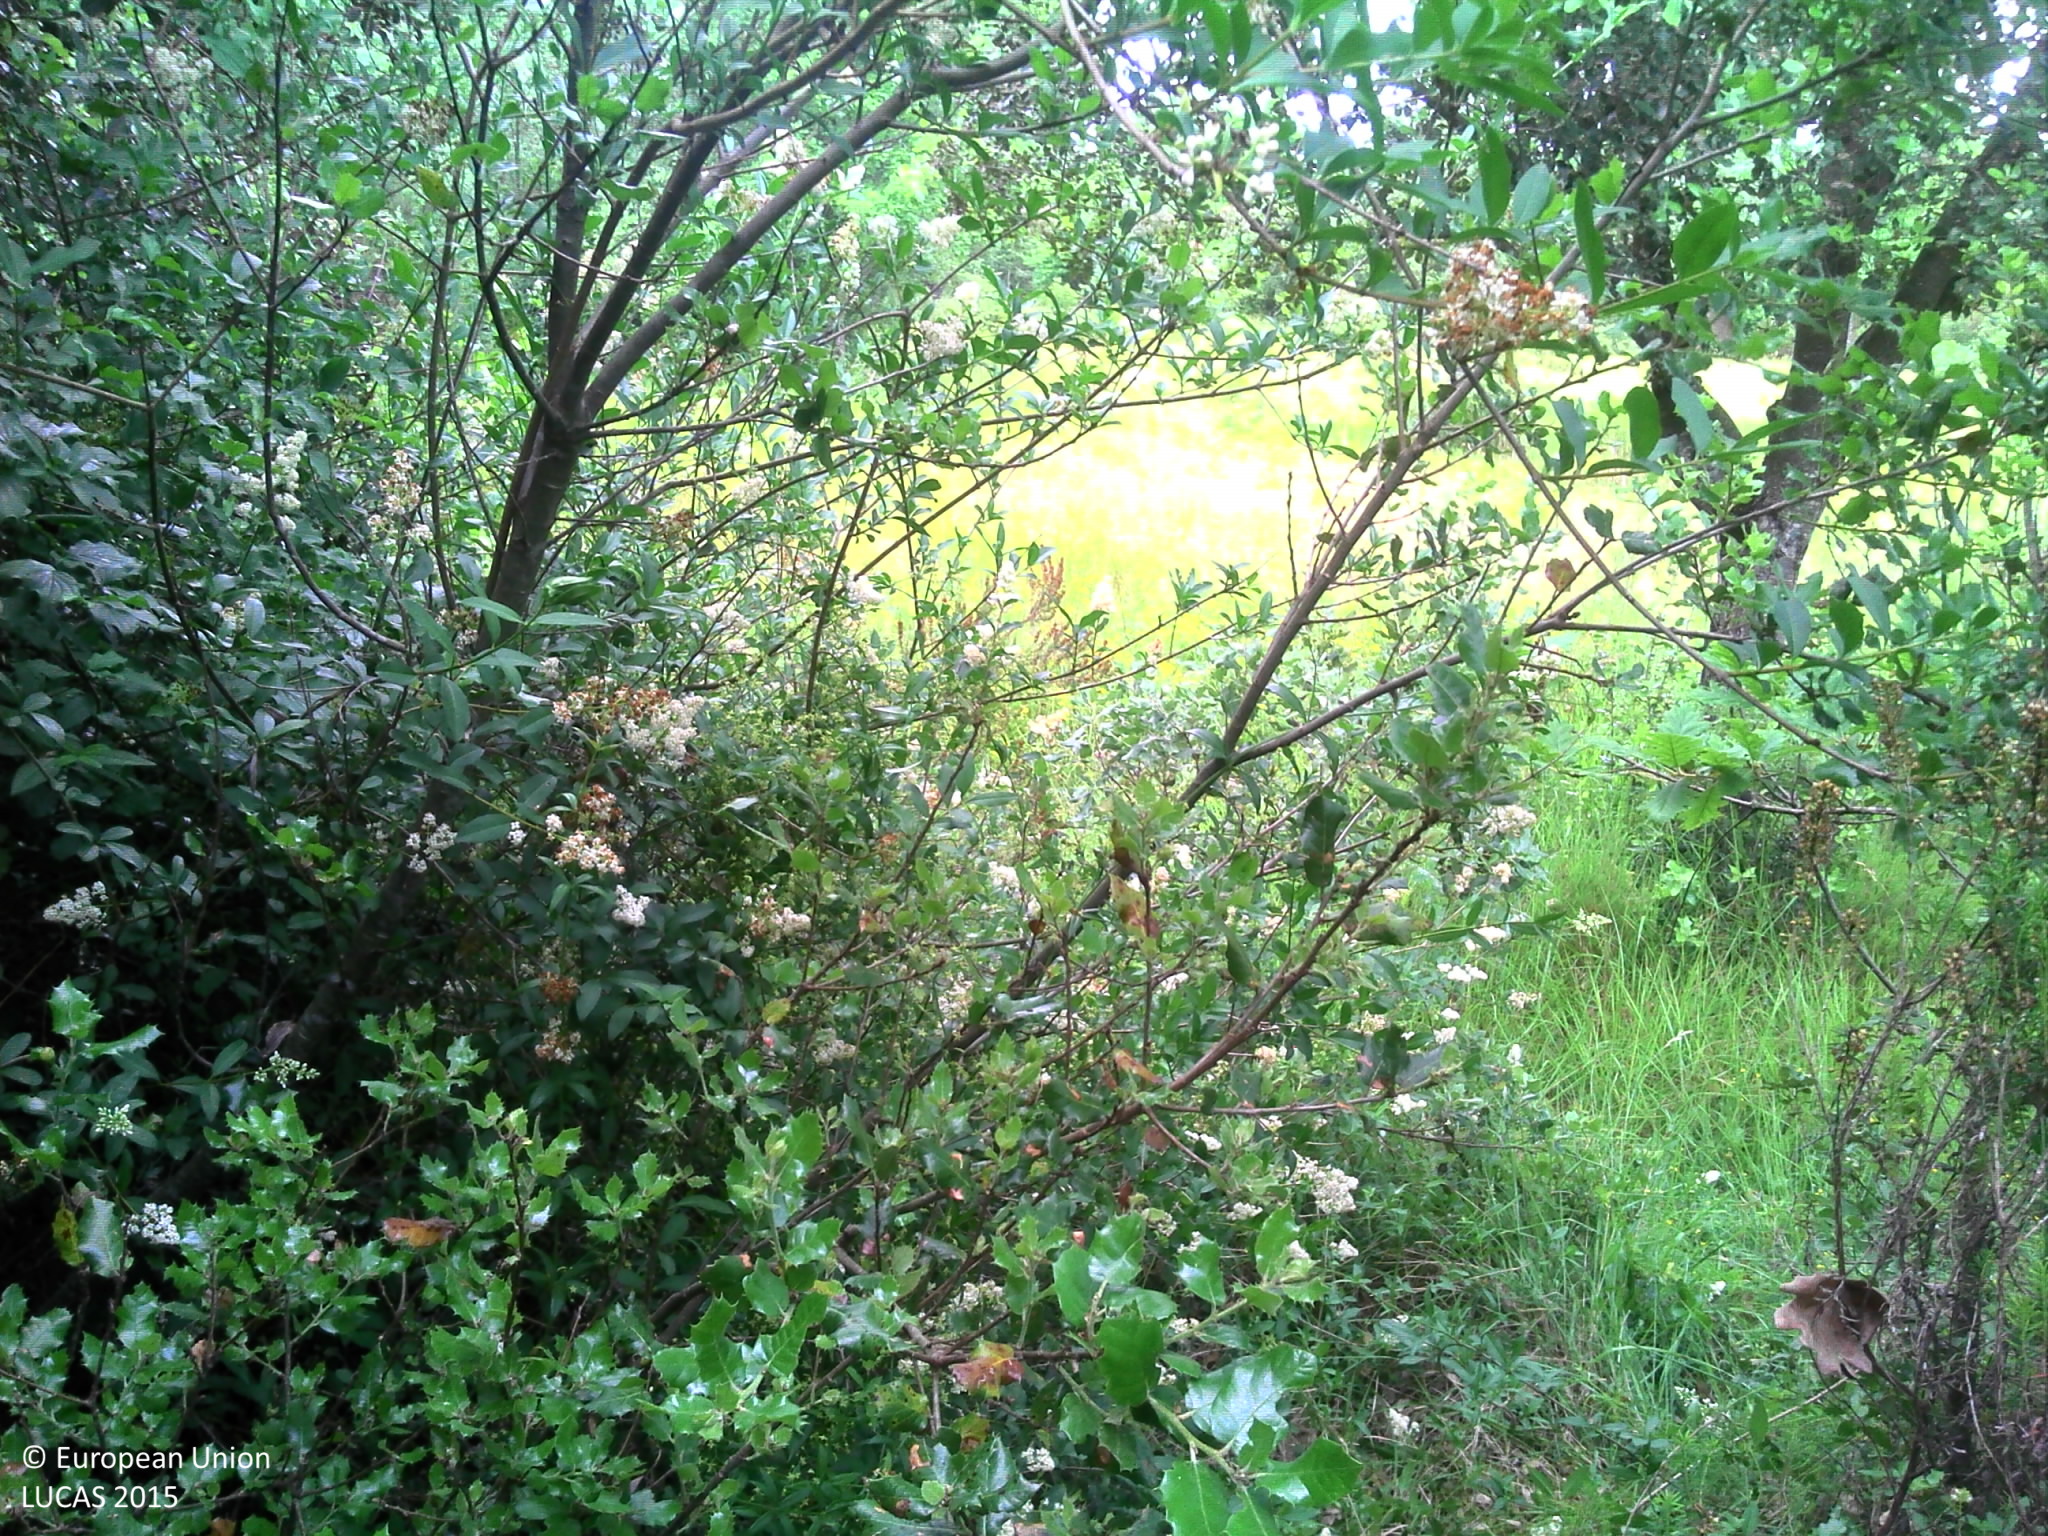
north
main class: Woodland
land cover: Broadleaved woodland
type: beech forest
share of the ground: 25 - 50 %
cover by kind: broadleaved forest trees 100 %
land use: Forestry
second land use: Amenities, museums, leisure
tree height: > 5 m
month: June
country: FR
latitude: 45.9000
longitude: -0.7370
